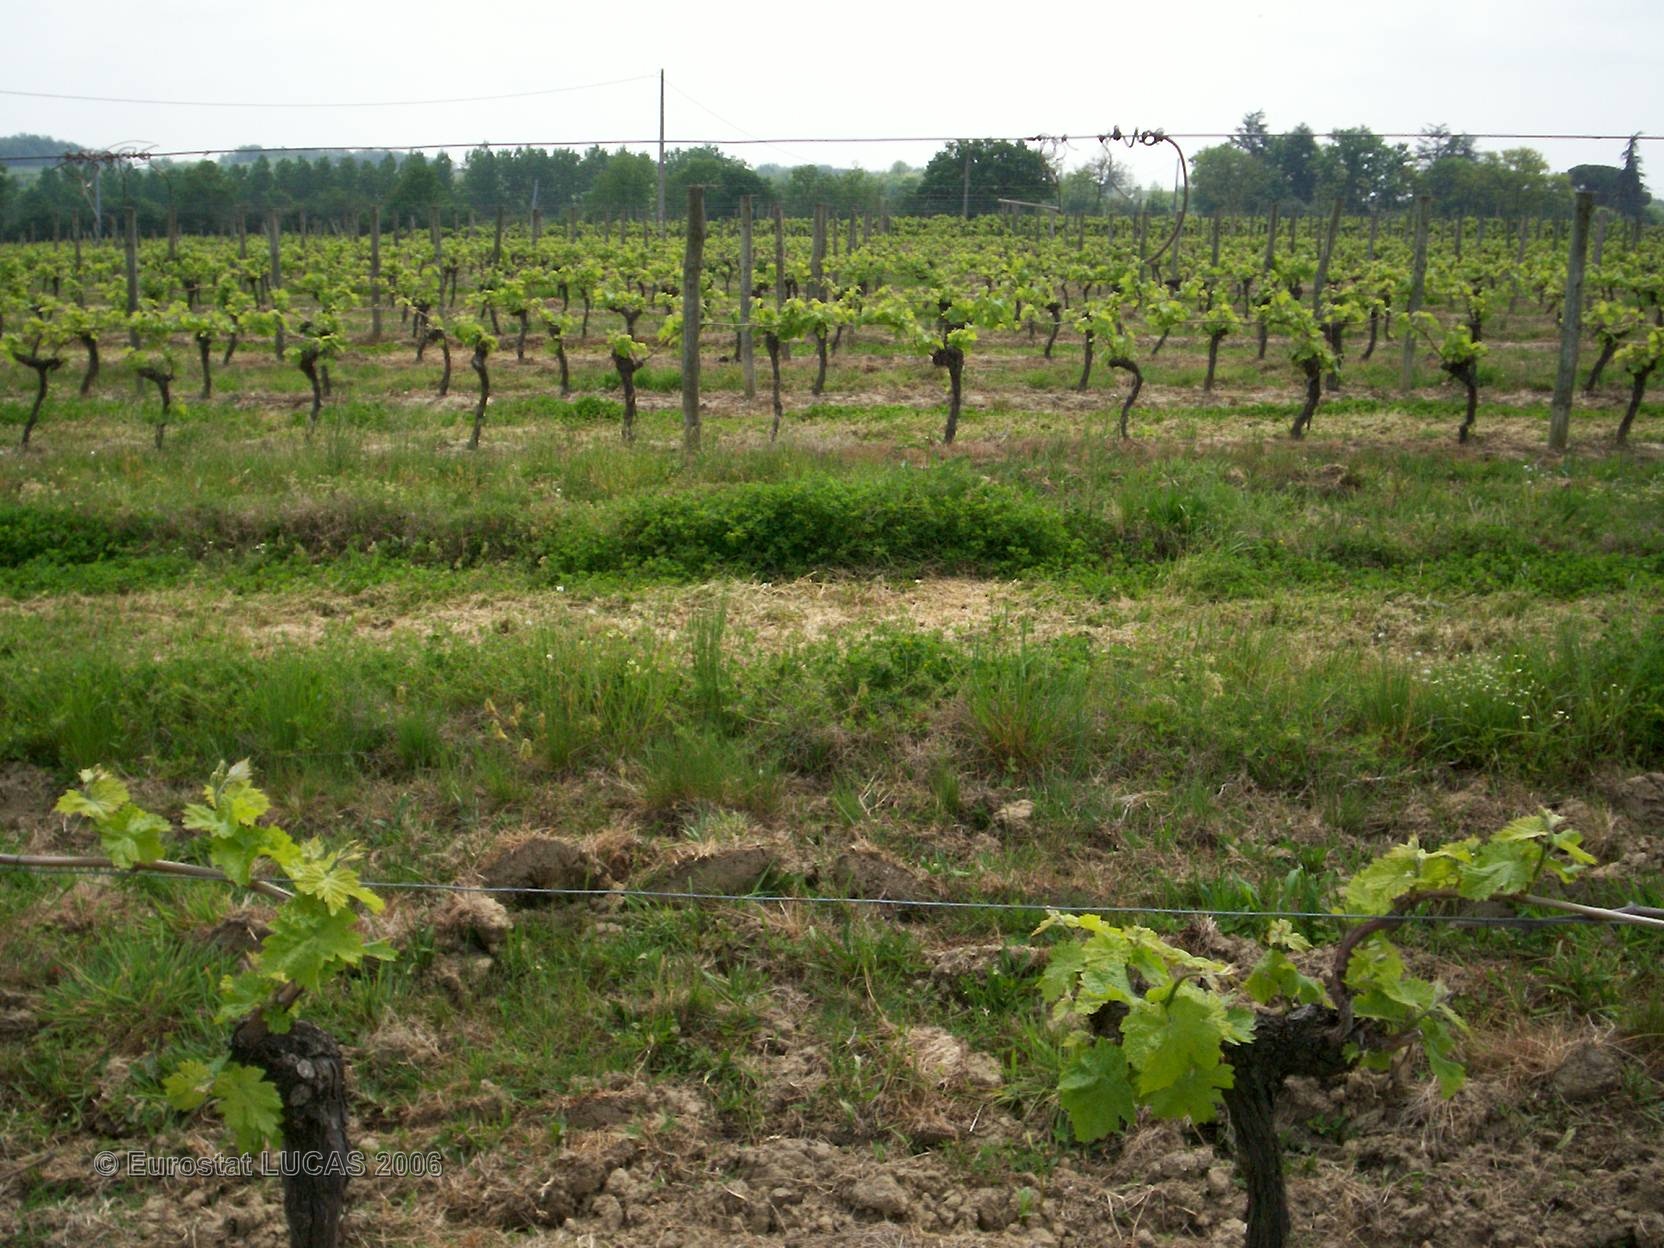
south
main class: Cropland
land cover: Vineyards
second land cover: Grassland with sparse tree/shrub cover
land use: Agriculture (excluding fallow land and kitchen gardens)
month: May
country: FR
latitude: 43.8831
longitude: 0.1732
